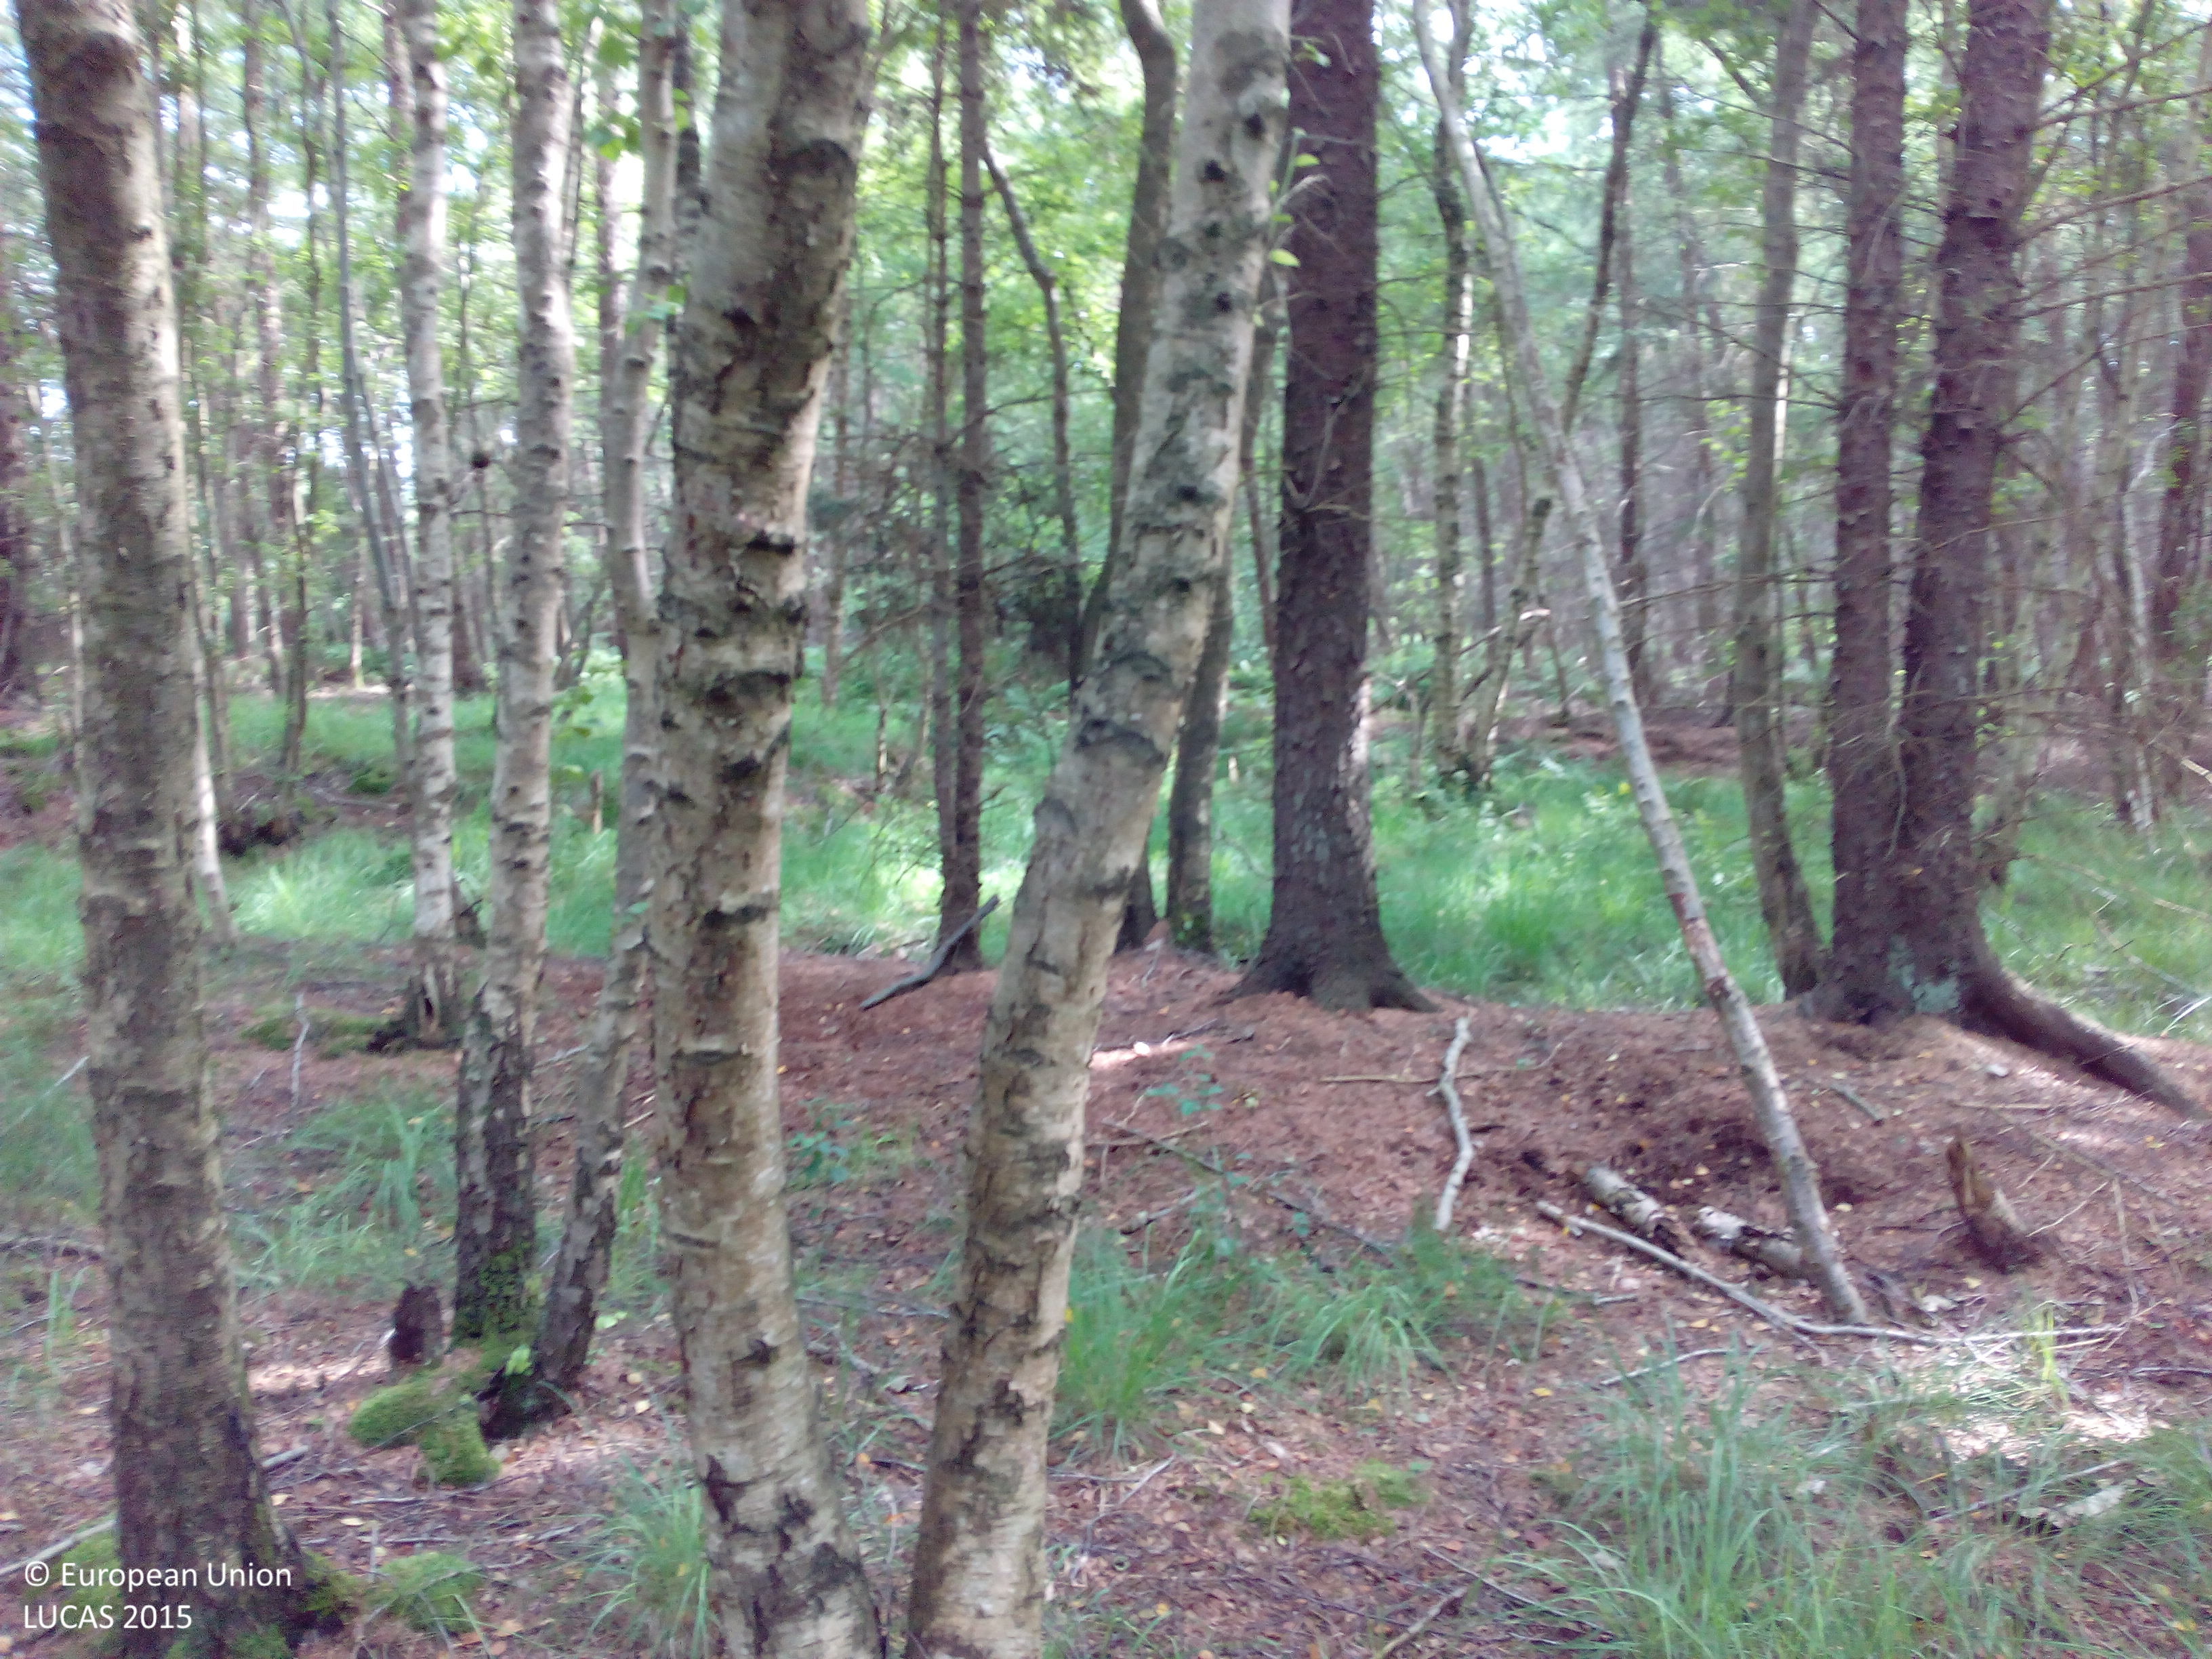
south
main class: Woodland
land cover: Broadleaved woodland
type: mire and swamp forests
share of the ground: > 75 %
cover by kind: broadleaved forest trees 85 %, coniferous forest trees 15 %
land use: Semi-natural and natural areas not in use
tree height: > 5 m
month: July
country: DE
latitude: 53.0426
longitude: 7.9274
